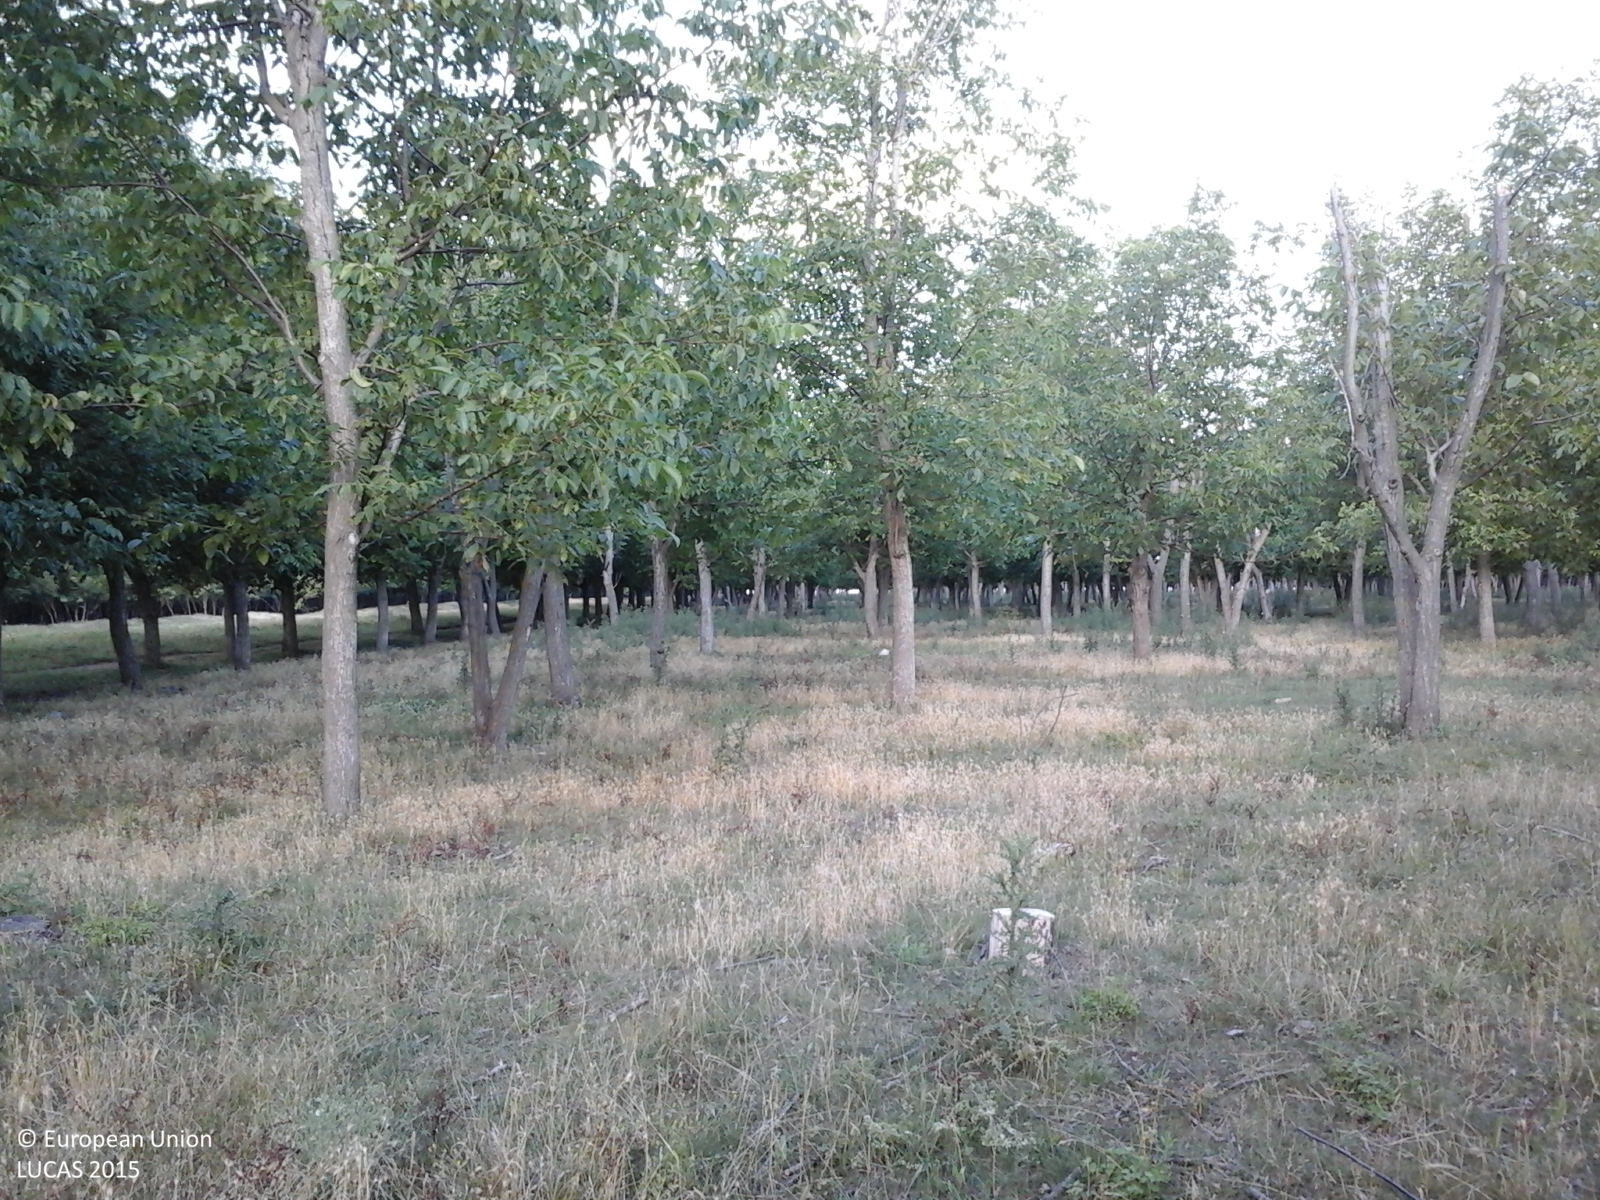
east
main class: Cropland
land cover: Nuts trees
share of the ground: 50 - 75 %
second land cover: Grassland without tree/shrub cover
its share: > 75 %
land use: Agriculture (excluding fallow land and kitchen gardens)
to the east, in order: Nuts trees; Grassland without tree/shrub cover; Tracks; Ditches and canals; Paved roads, cycling and walking lanes; Ditches and canals; Broadleaved woodland
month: July
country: RO
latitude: 43.9432
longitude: 24.4045
